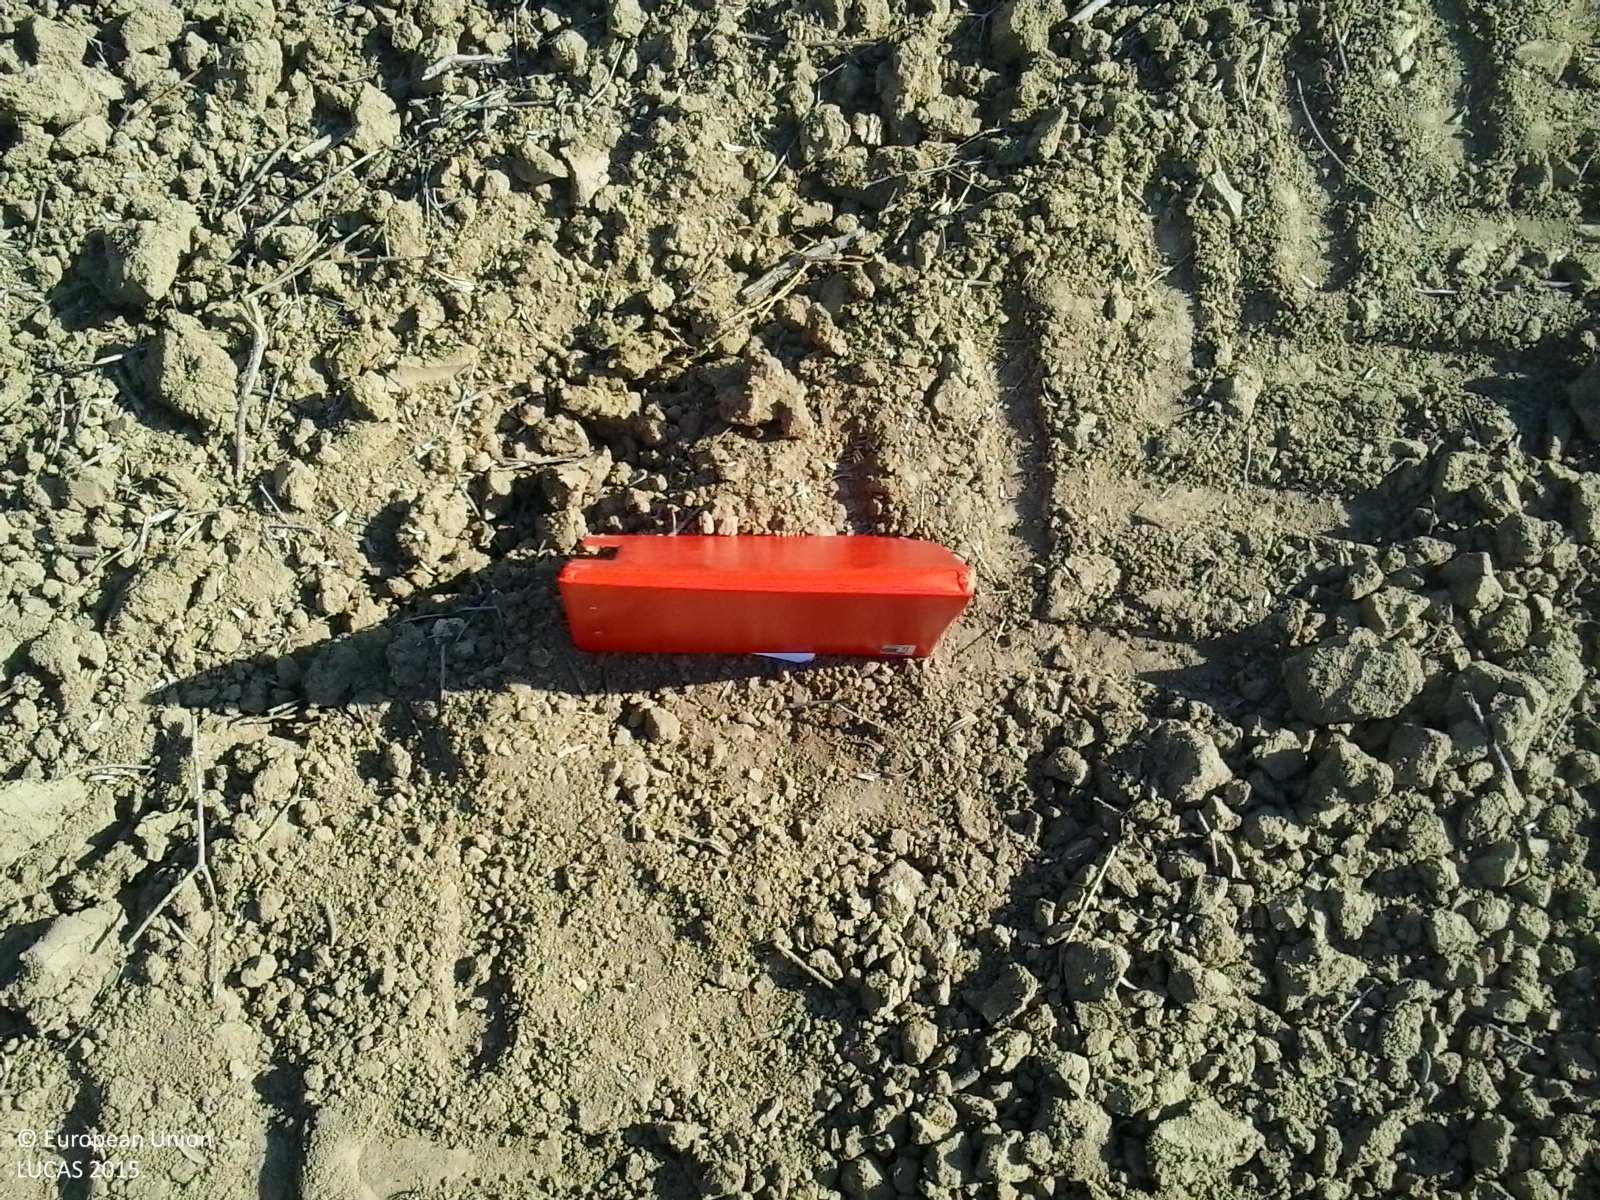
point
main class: Cropland
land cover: Olive groves
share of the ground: 25 - 50 %
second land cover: Other bare soil
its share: > 75 %
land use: Agriculture (excluding fallow land and kitchen gardens)
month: June
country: ES
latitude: 37.4404
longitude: -6.1791
